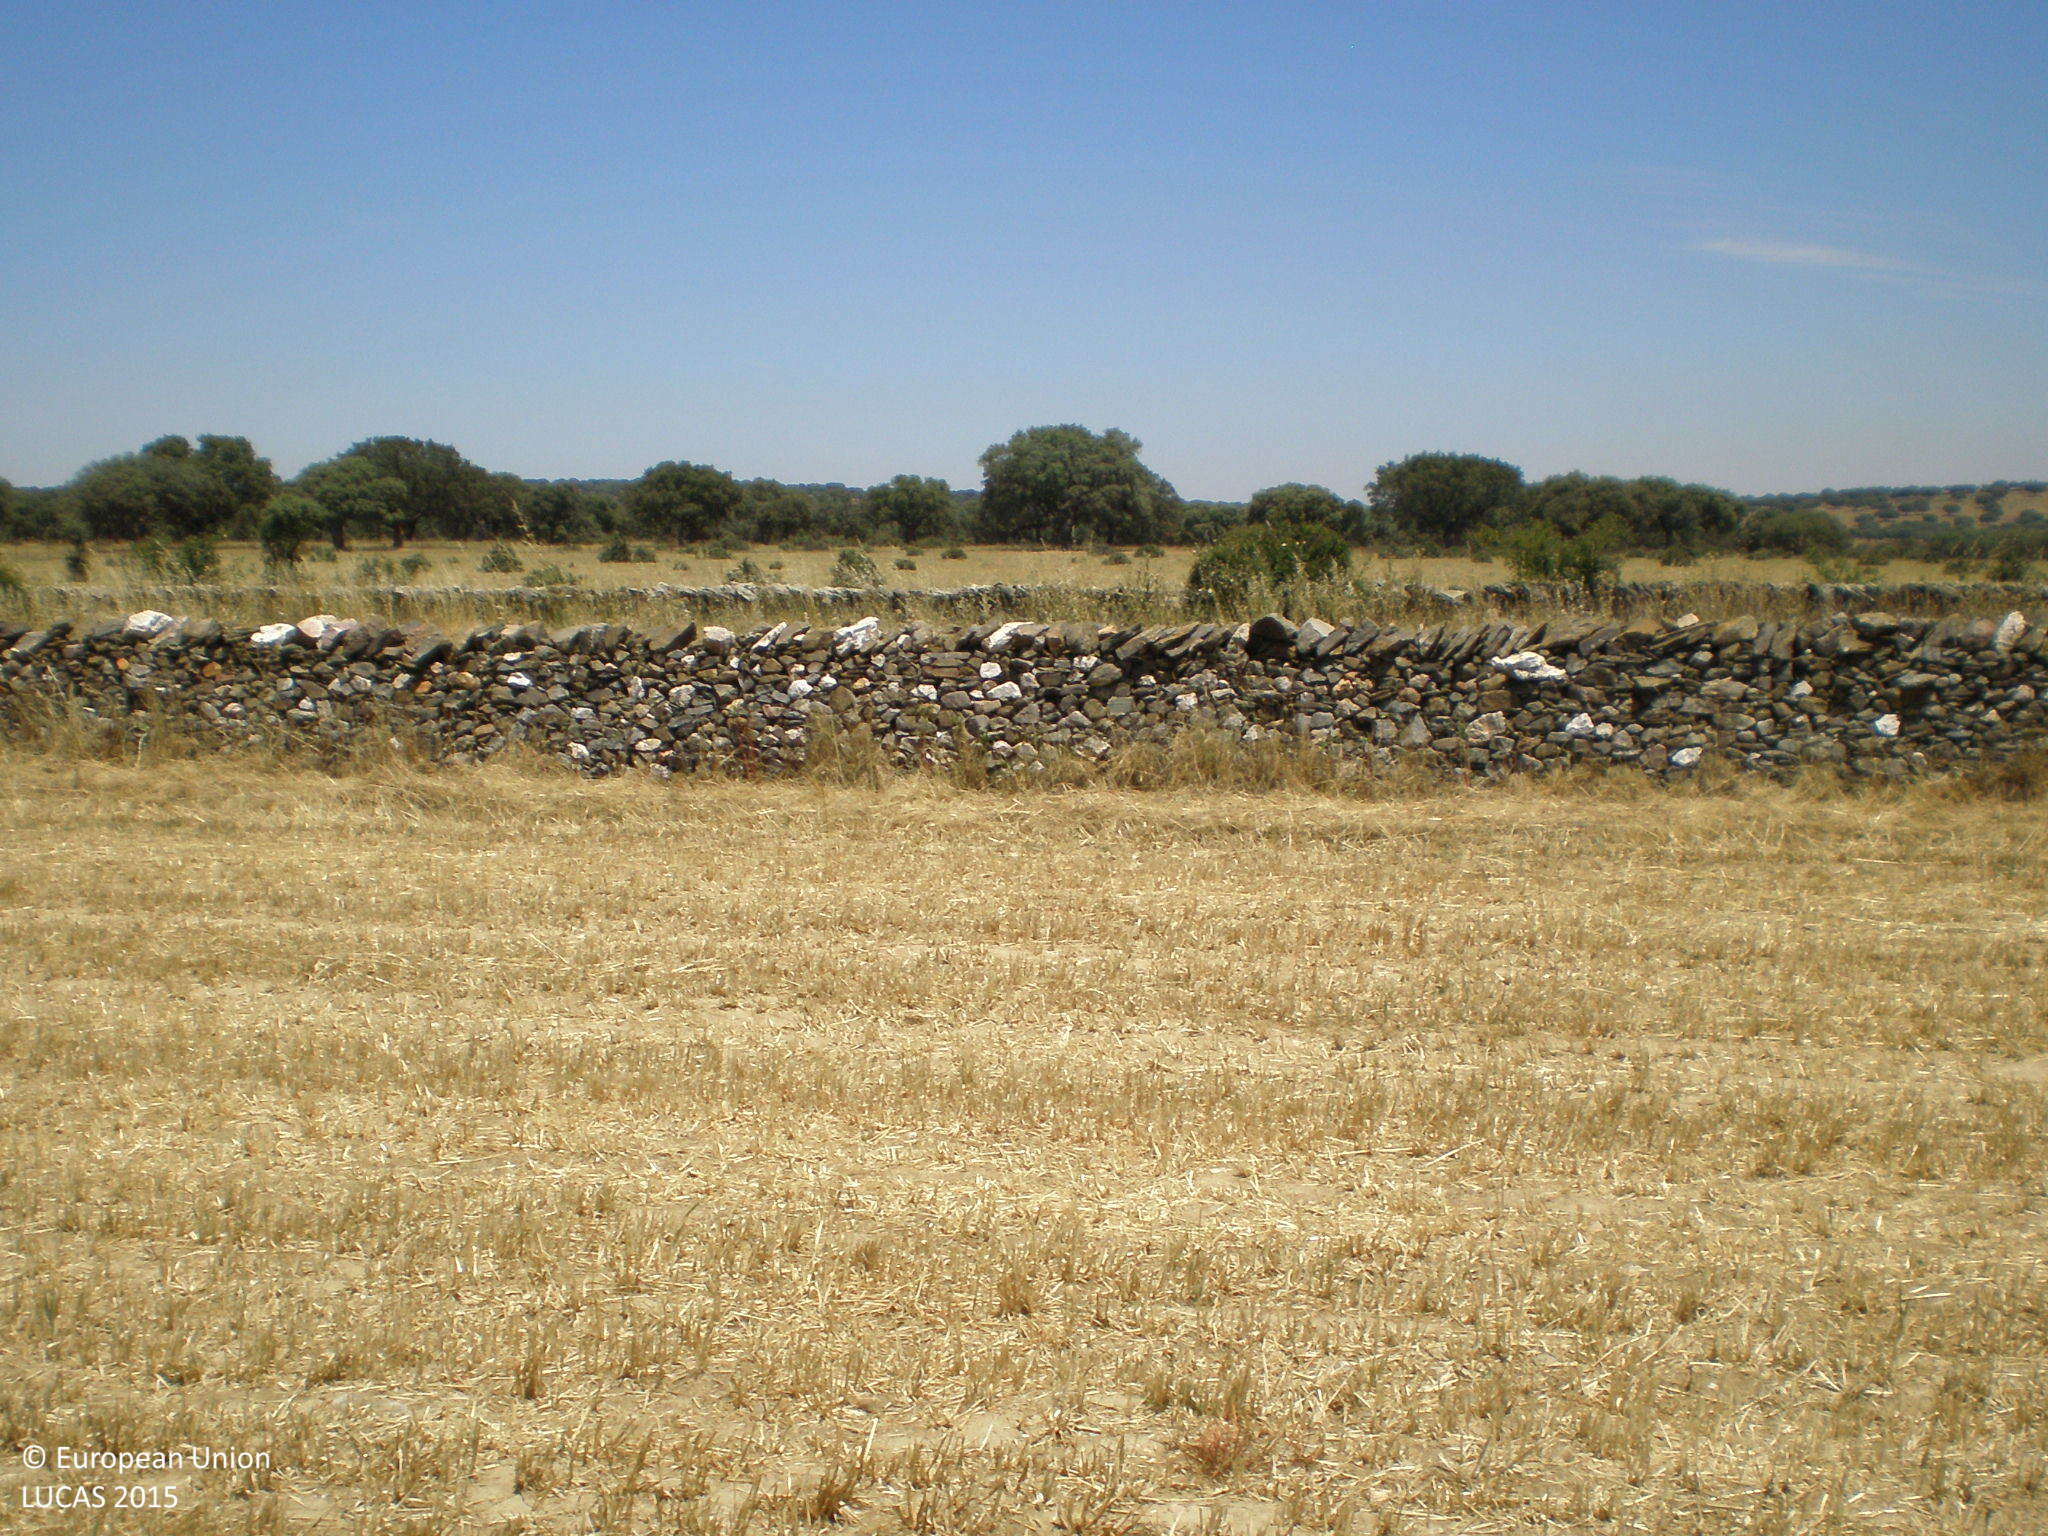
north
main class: Cropland
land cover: Oats
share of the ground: < 10 %
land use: Agriculture (excluding fallow land and kitchen gardens)
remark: Harvested field
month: June
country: ES
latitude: 40.7547
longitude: -5.8430
